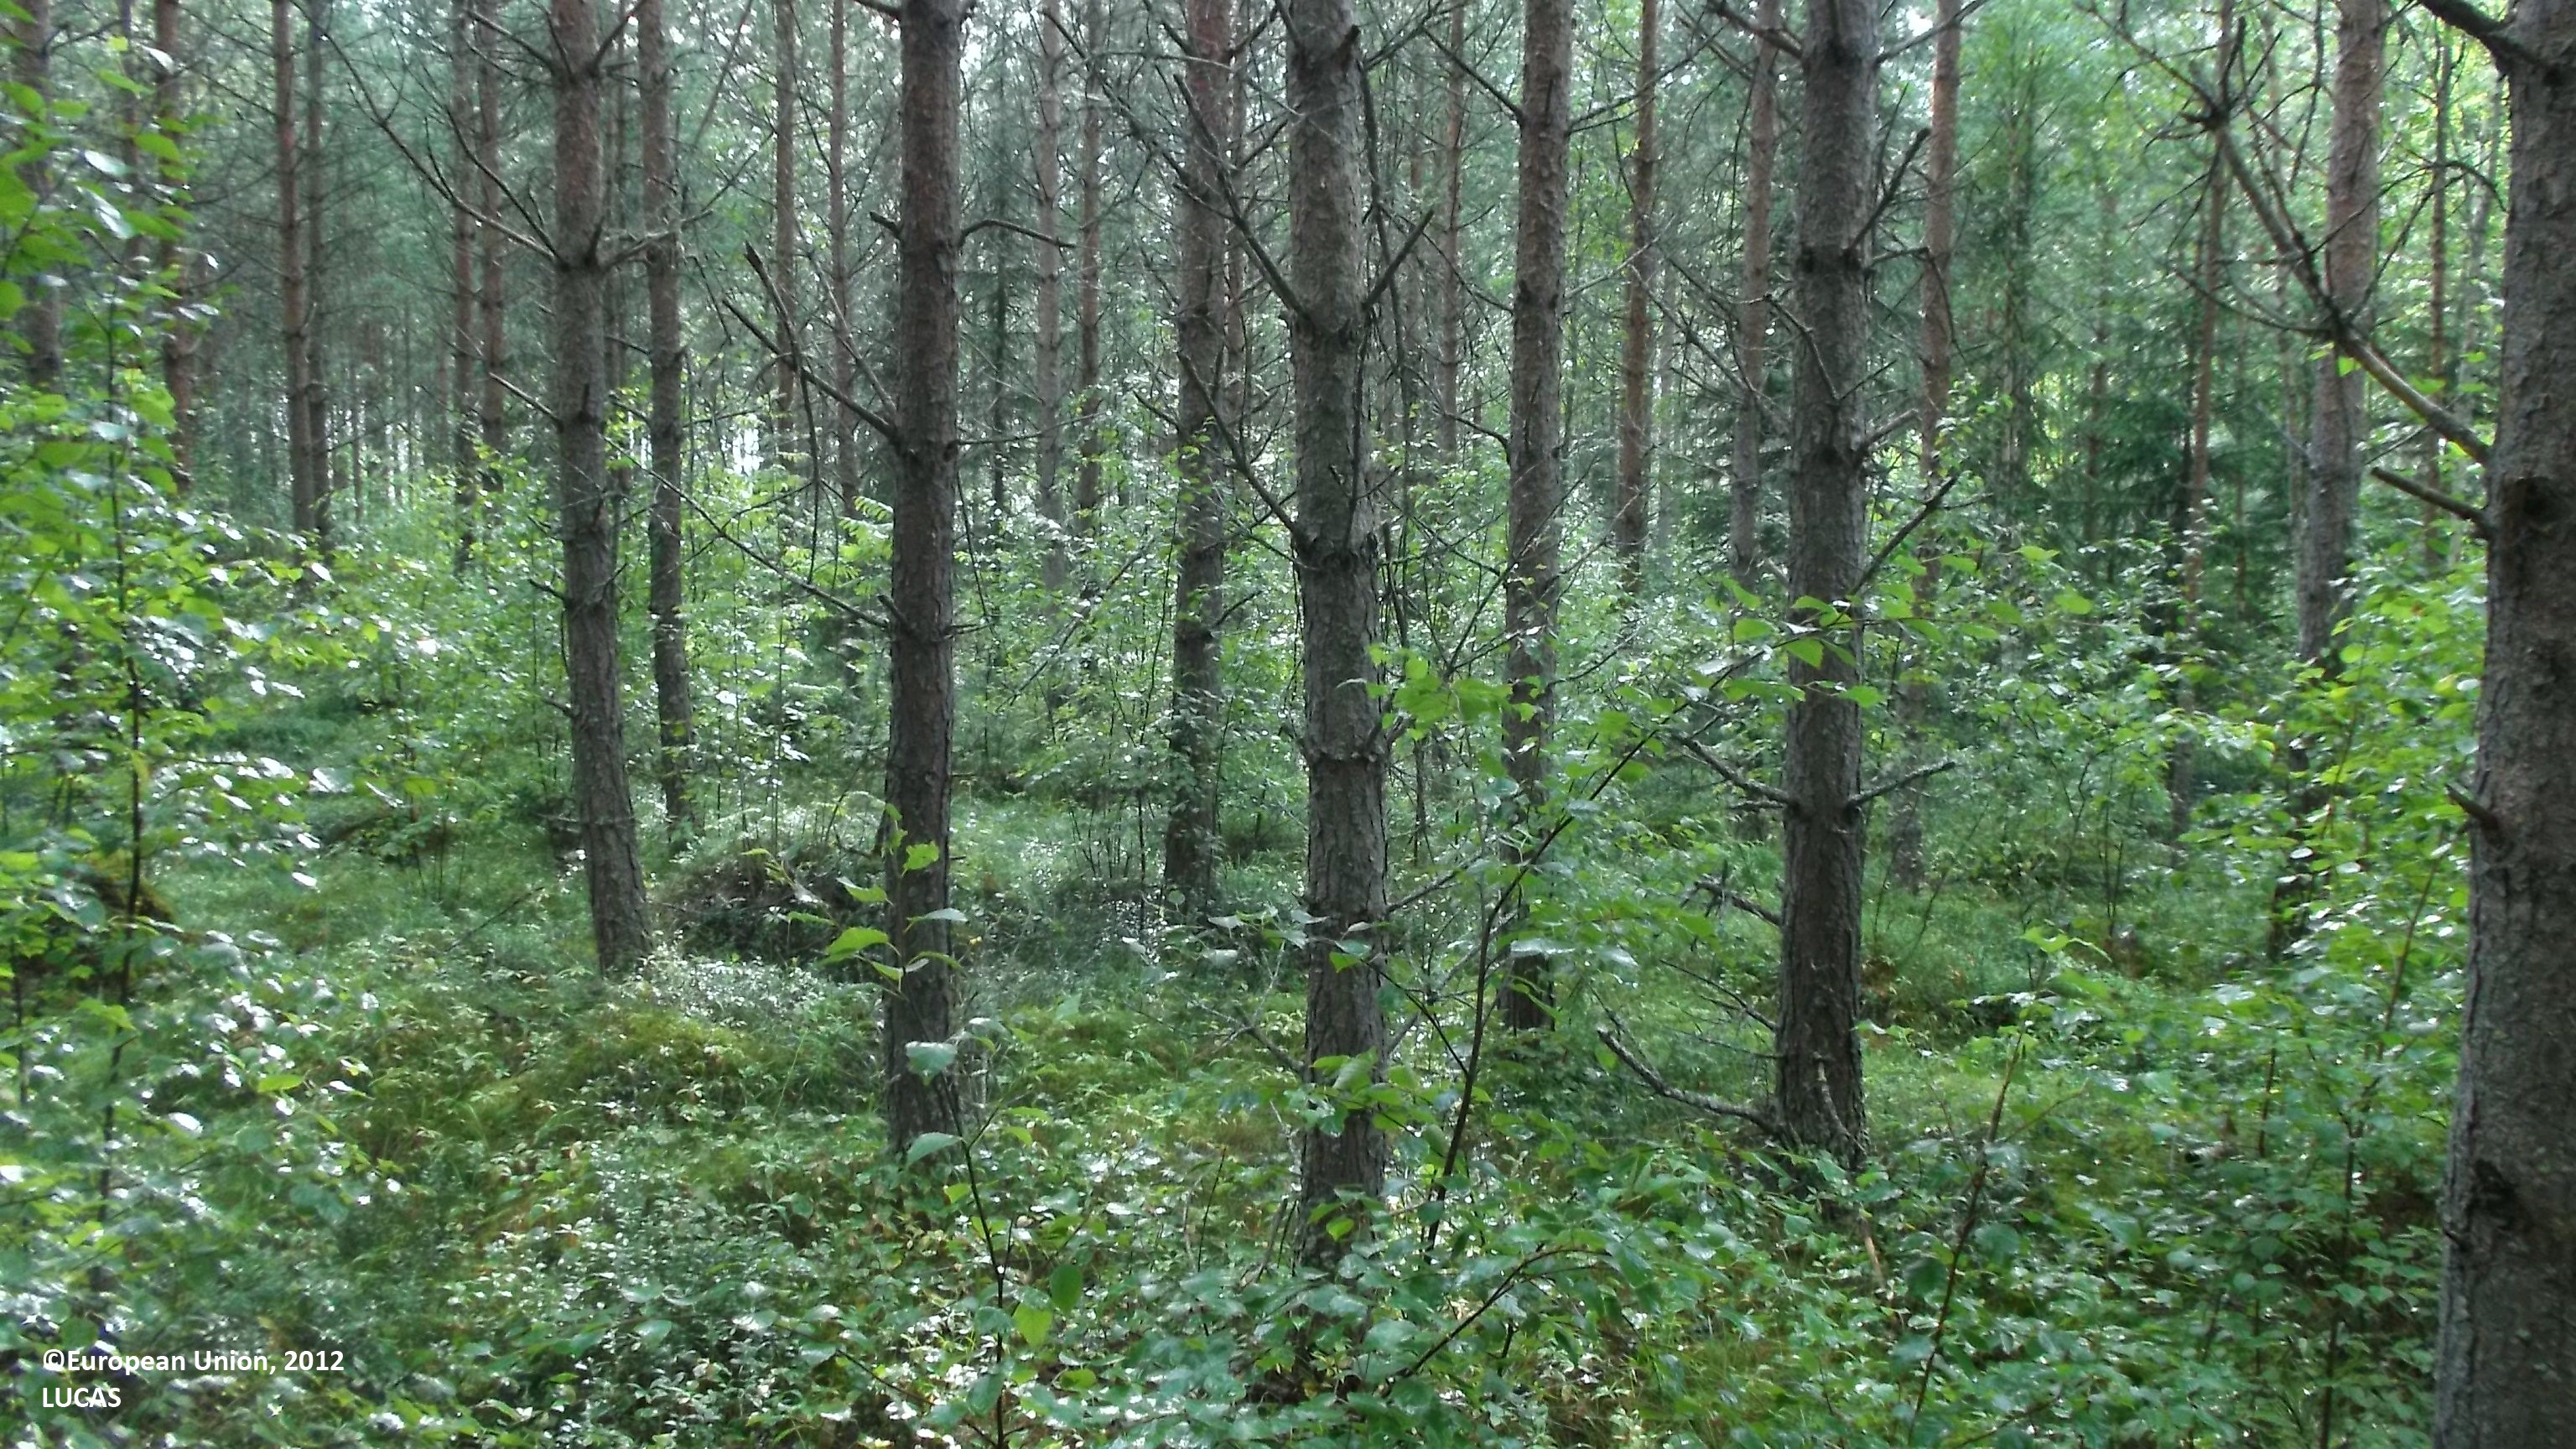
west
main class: Woodland
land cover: Pine dominated coniferous woodland
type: boreal forest
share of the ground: 50 - 75 %
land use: Forestry
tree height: > 5 m
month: August
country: FI
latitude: 63.9320
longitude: 23.4574
